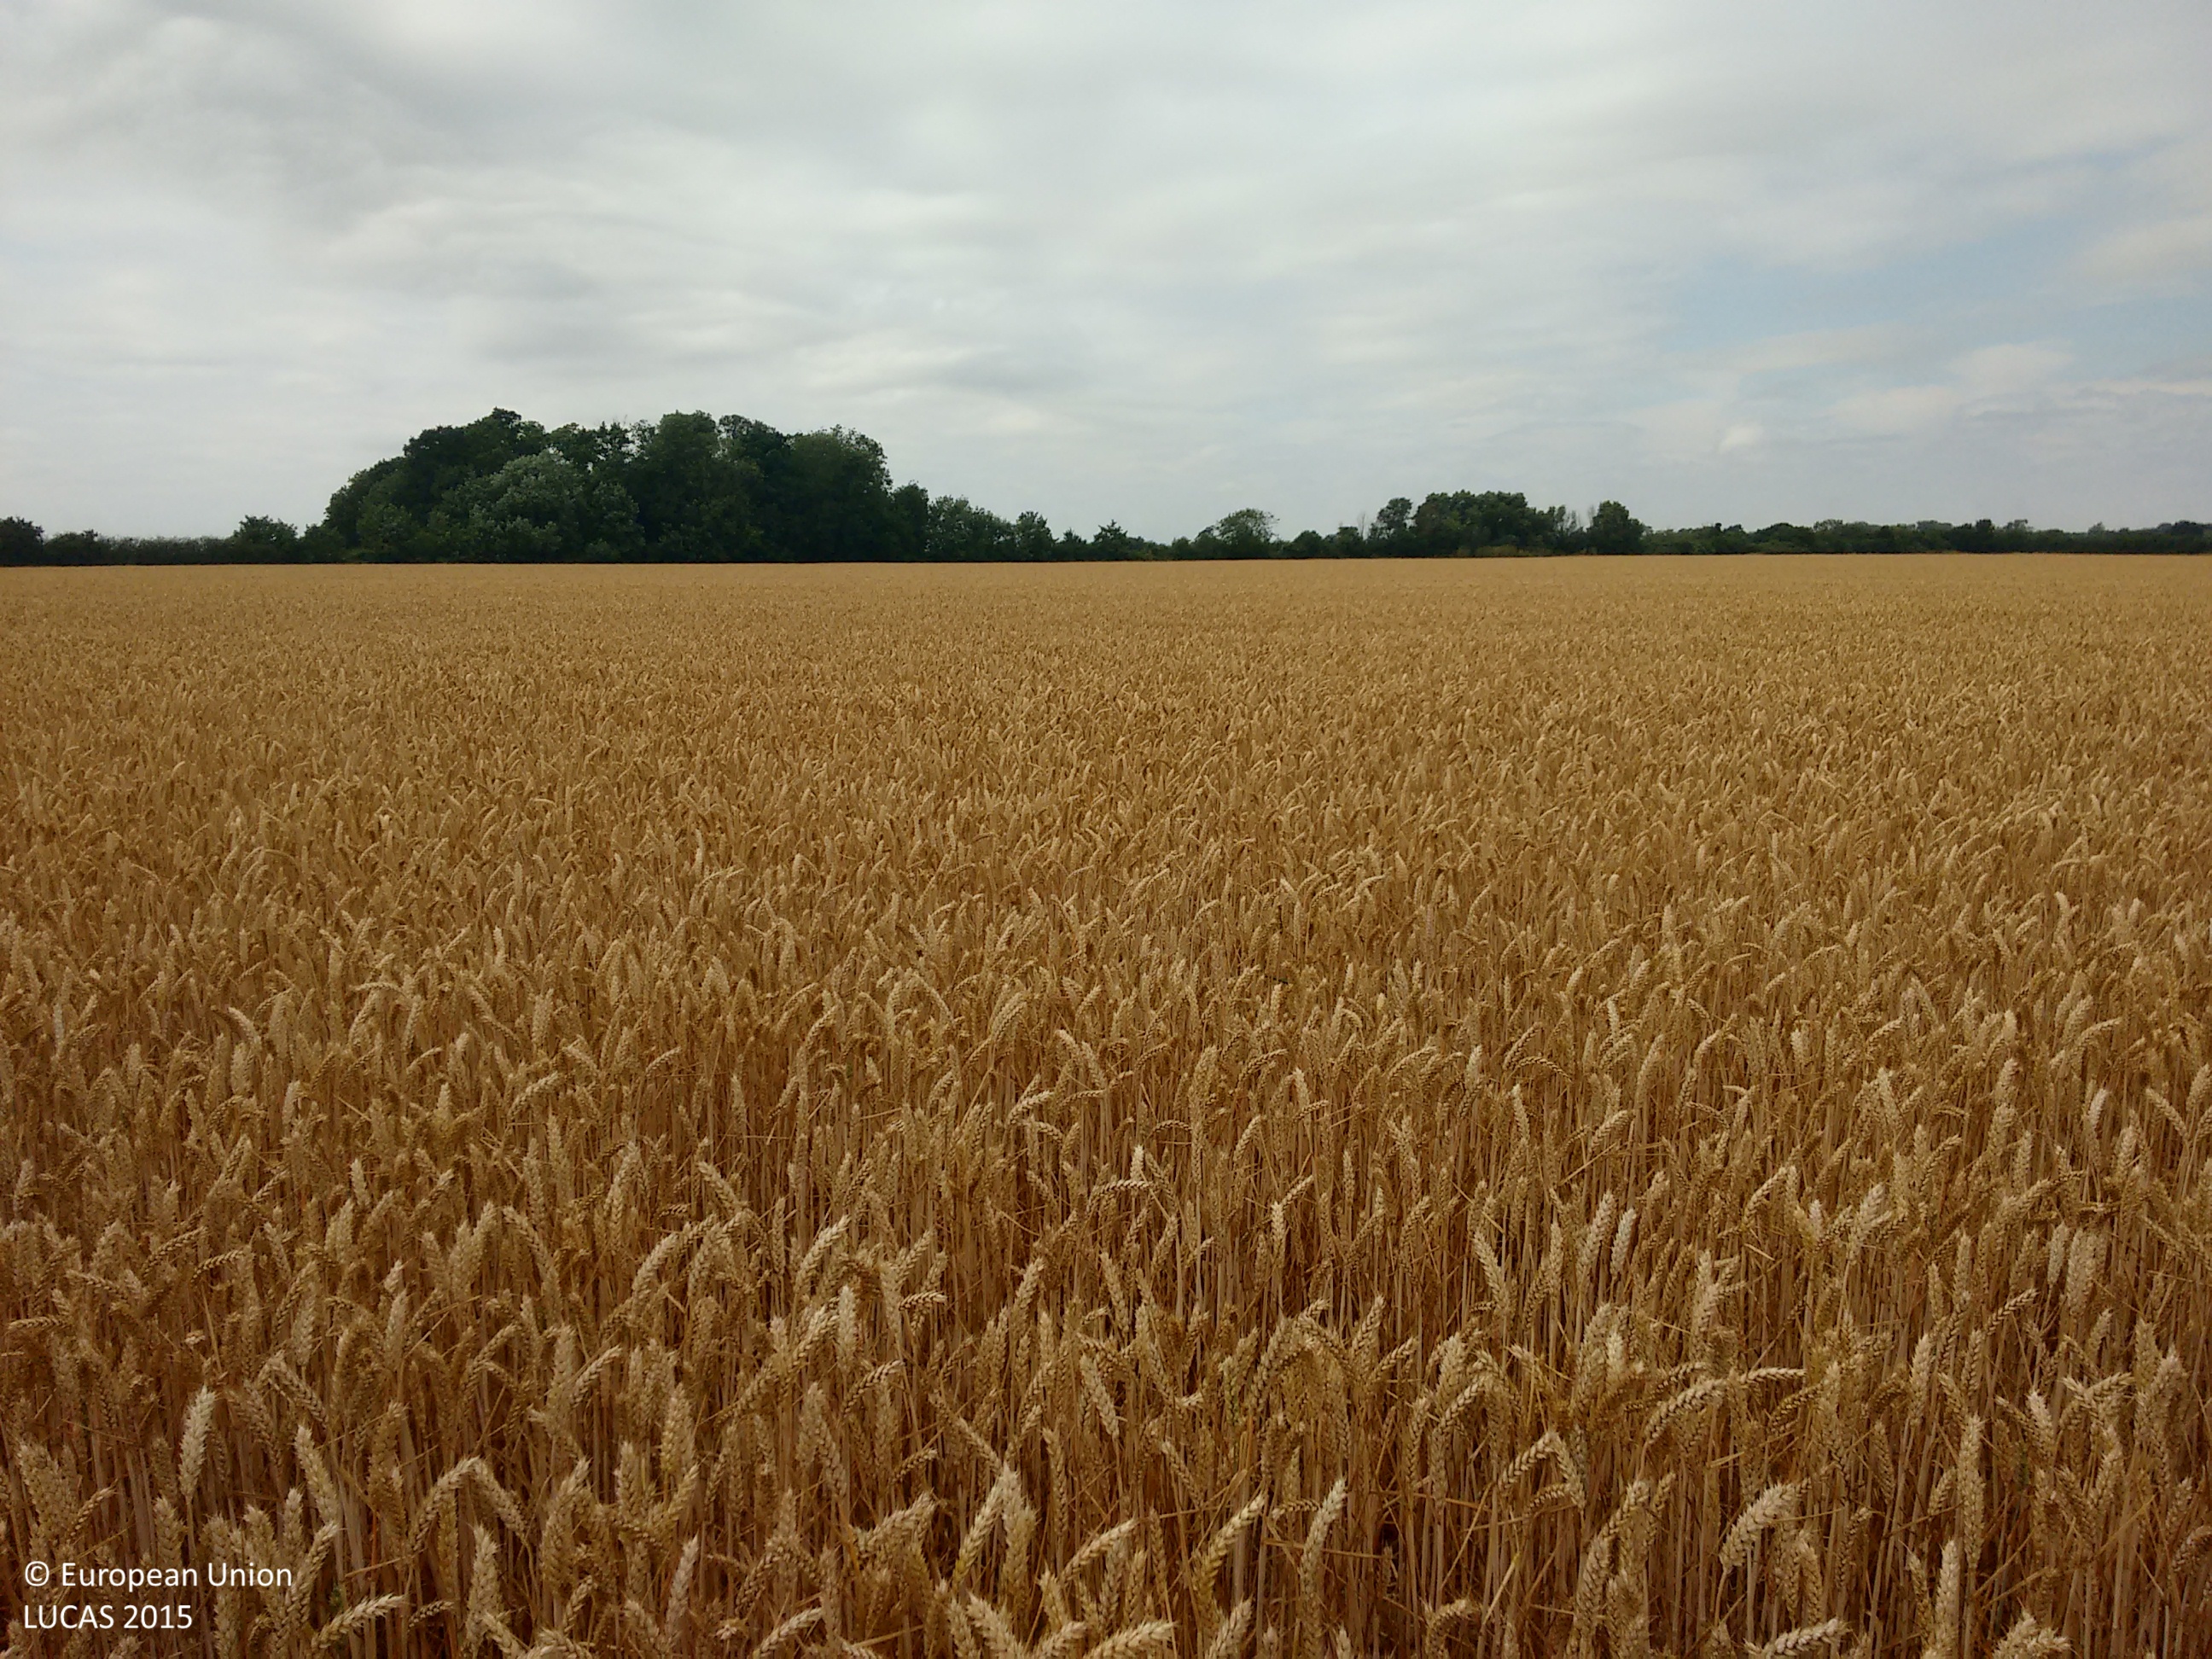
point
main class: Cropland
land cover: Common wheat
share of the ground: > 75 %
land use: Agriculture (excluding fallow land and kitchen gardens)
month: July
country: GB
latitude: 51.7744
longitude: 0.4499
